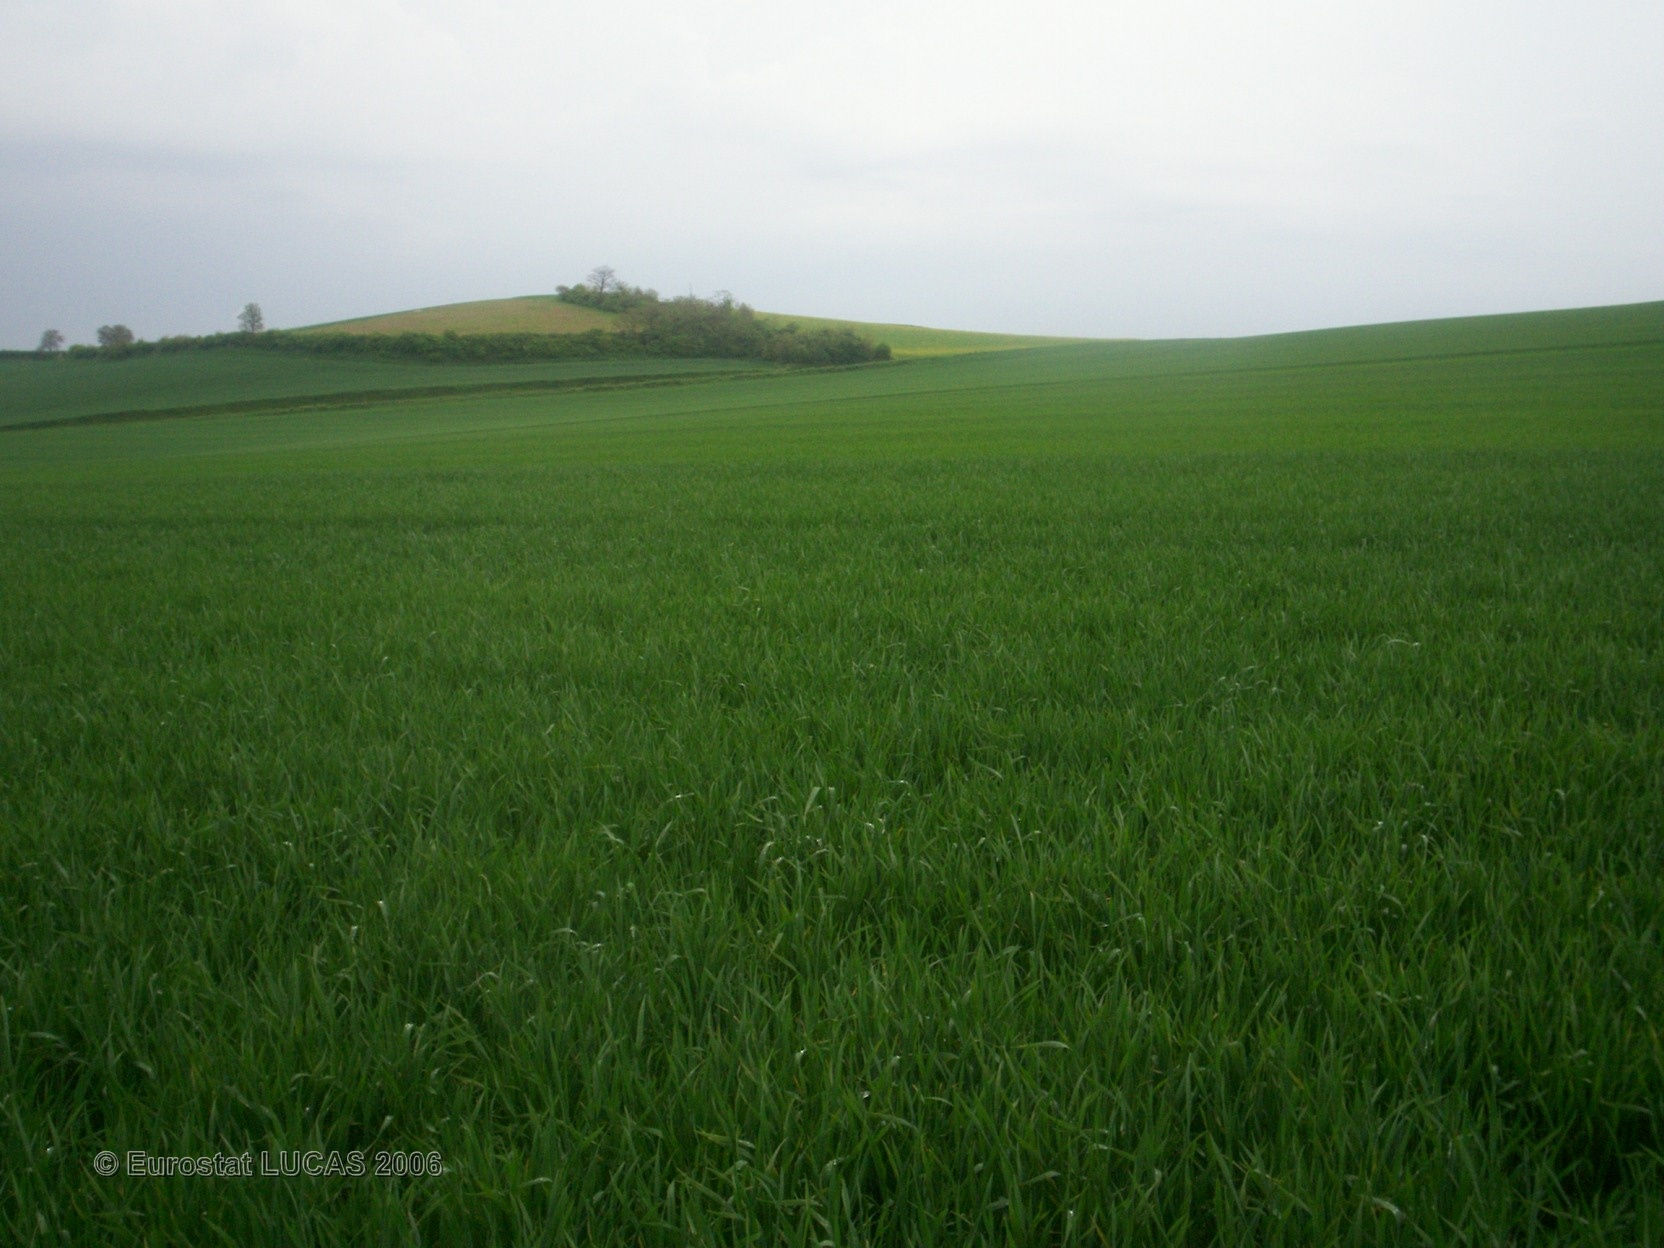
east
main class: Cropland
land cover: Common wheat
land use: Agriculture (excluding fallow land and kitchen gardens)
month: May
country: FR
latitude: 46.0224
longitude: 3.1398
